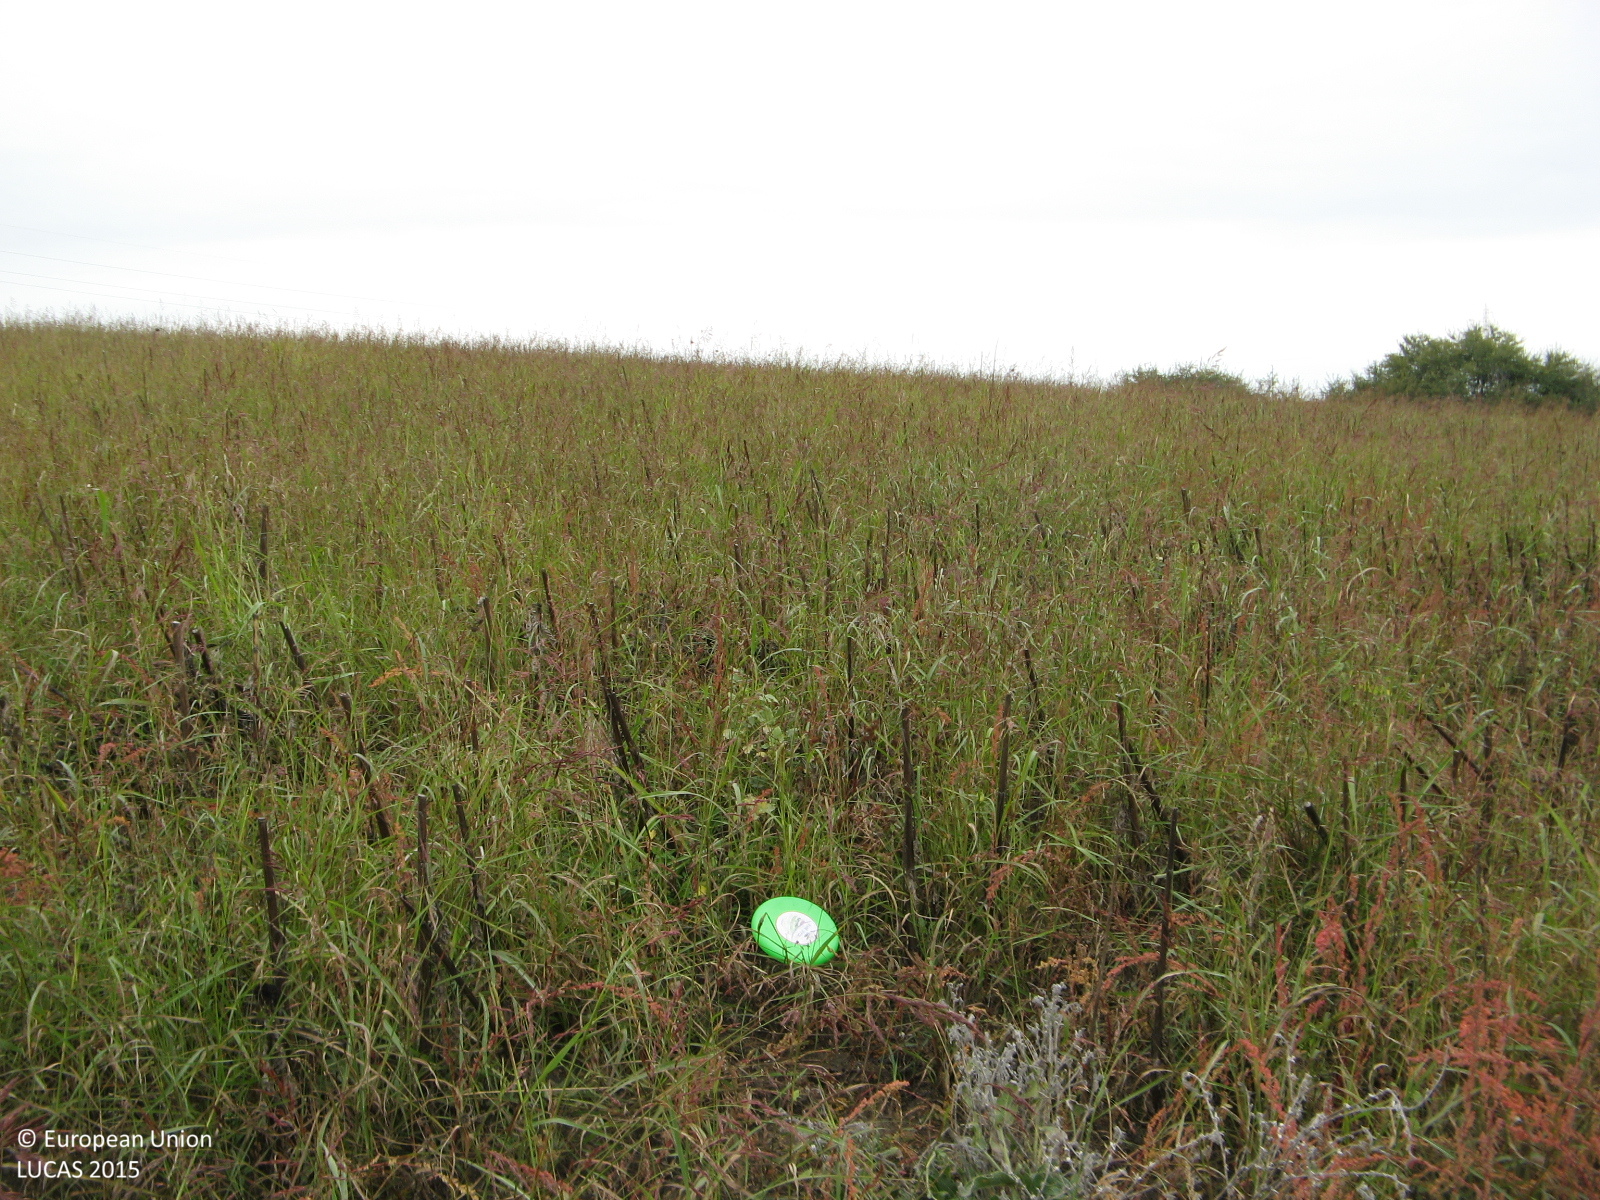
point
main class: Cropland
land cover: Sunflower
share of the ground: 10 - 25 %
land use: Agriculture (excluding fallow land and kitchen gardens)
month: October
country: BG
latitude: 42.0711
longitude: 25.1784
